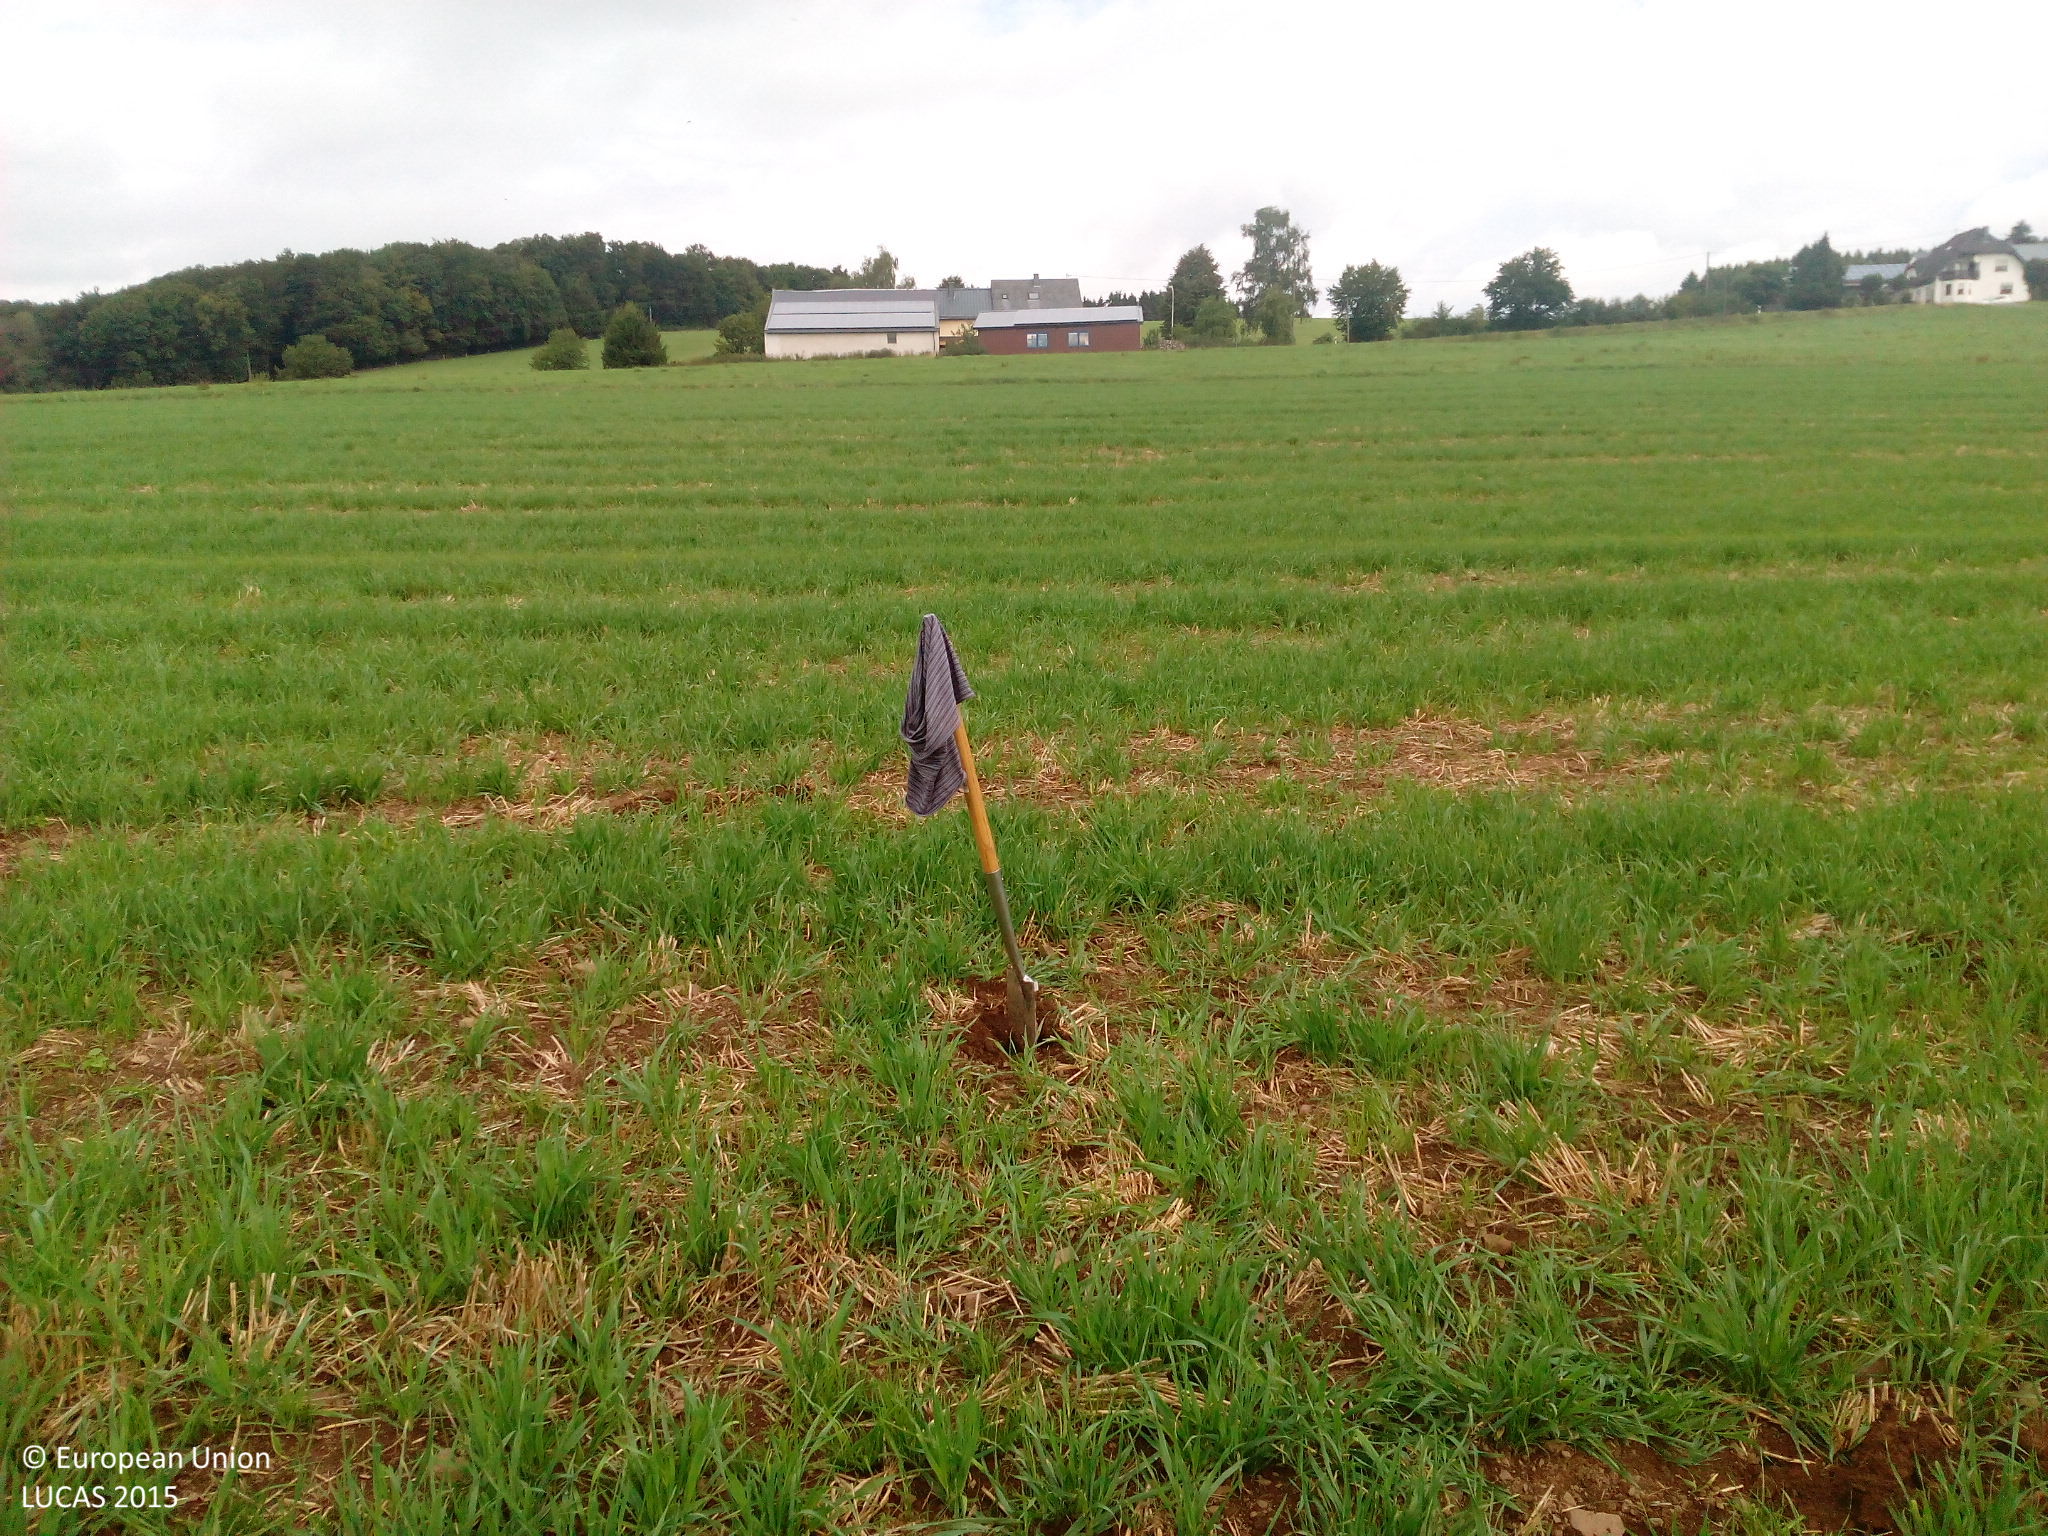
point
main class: Cropland
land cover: Barley
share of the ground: < 10 %
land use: Agriculture (excluding fallow land and kitchen gardens)
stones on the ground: < 10 %
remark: Harvested field
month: August
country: DE
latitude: 50.2138
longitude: 6.2858
